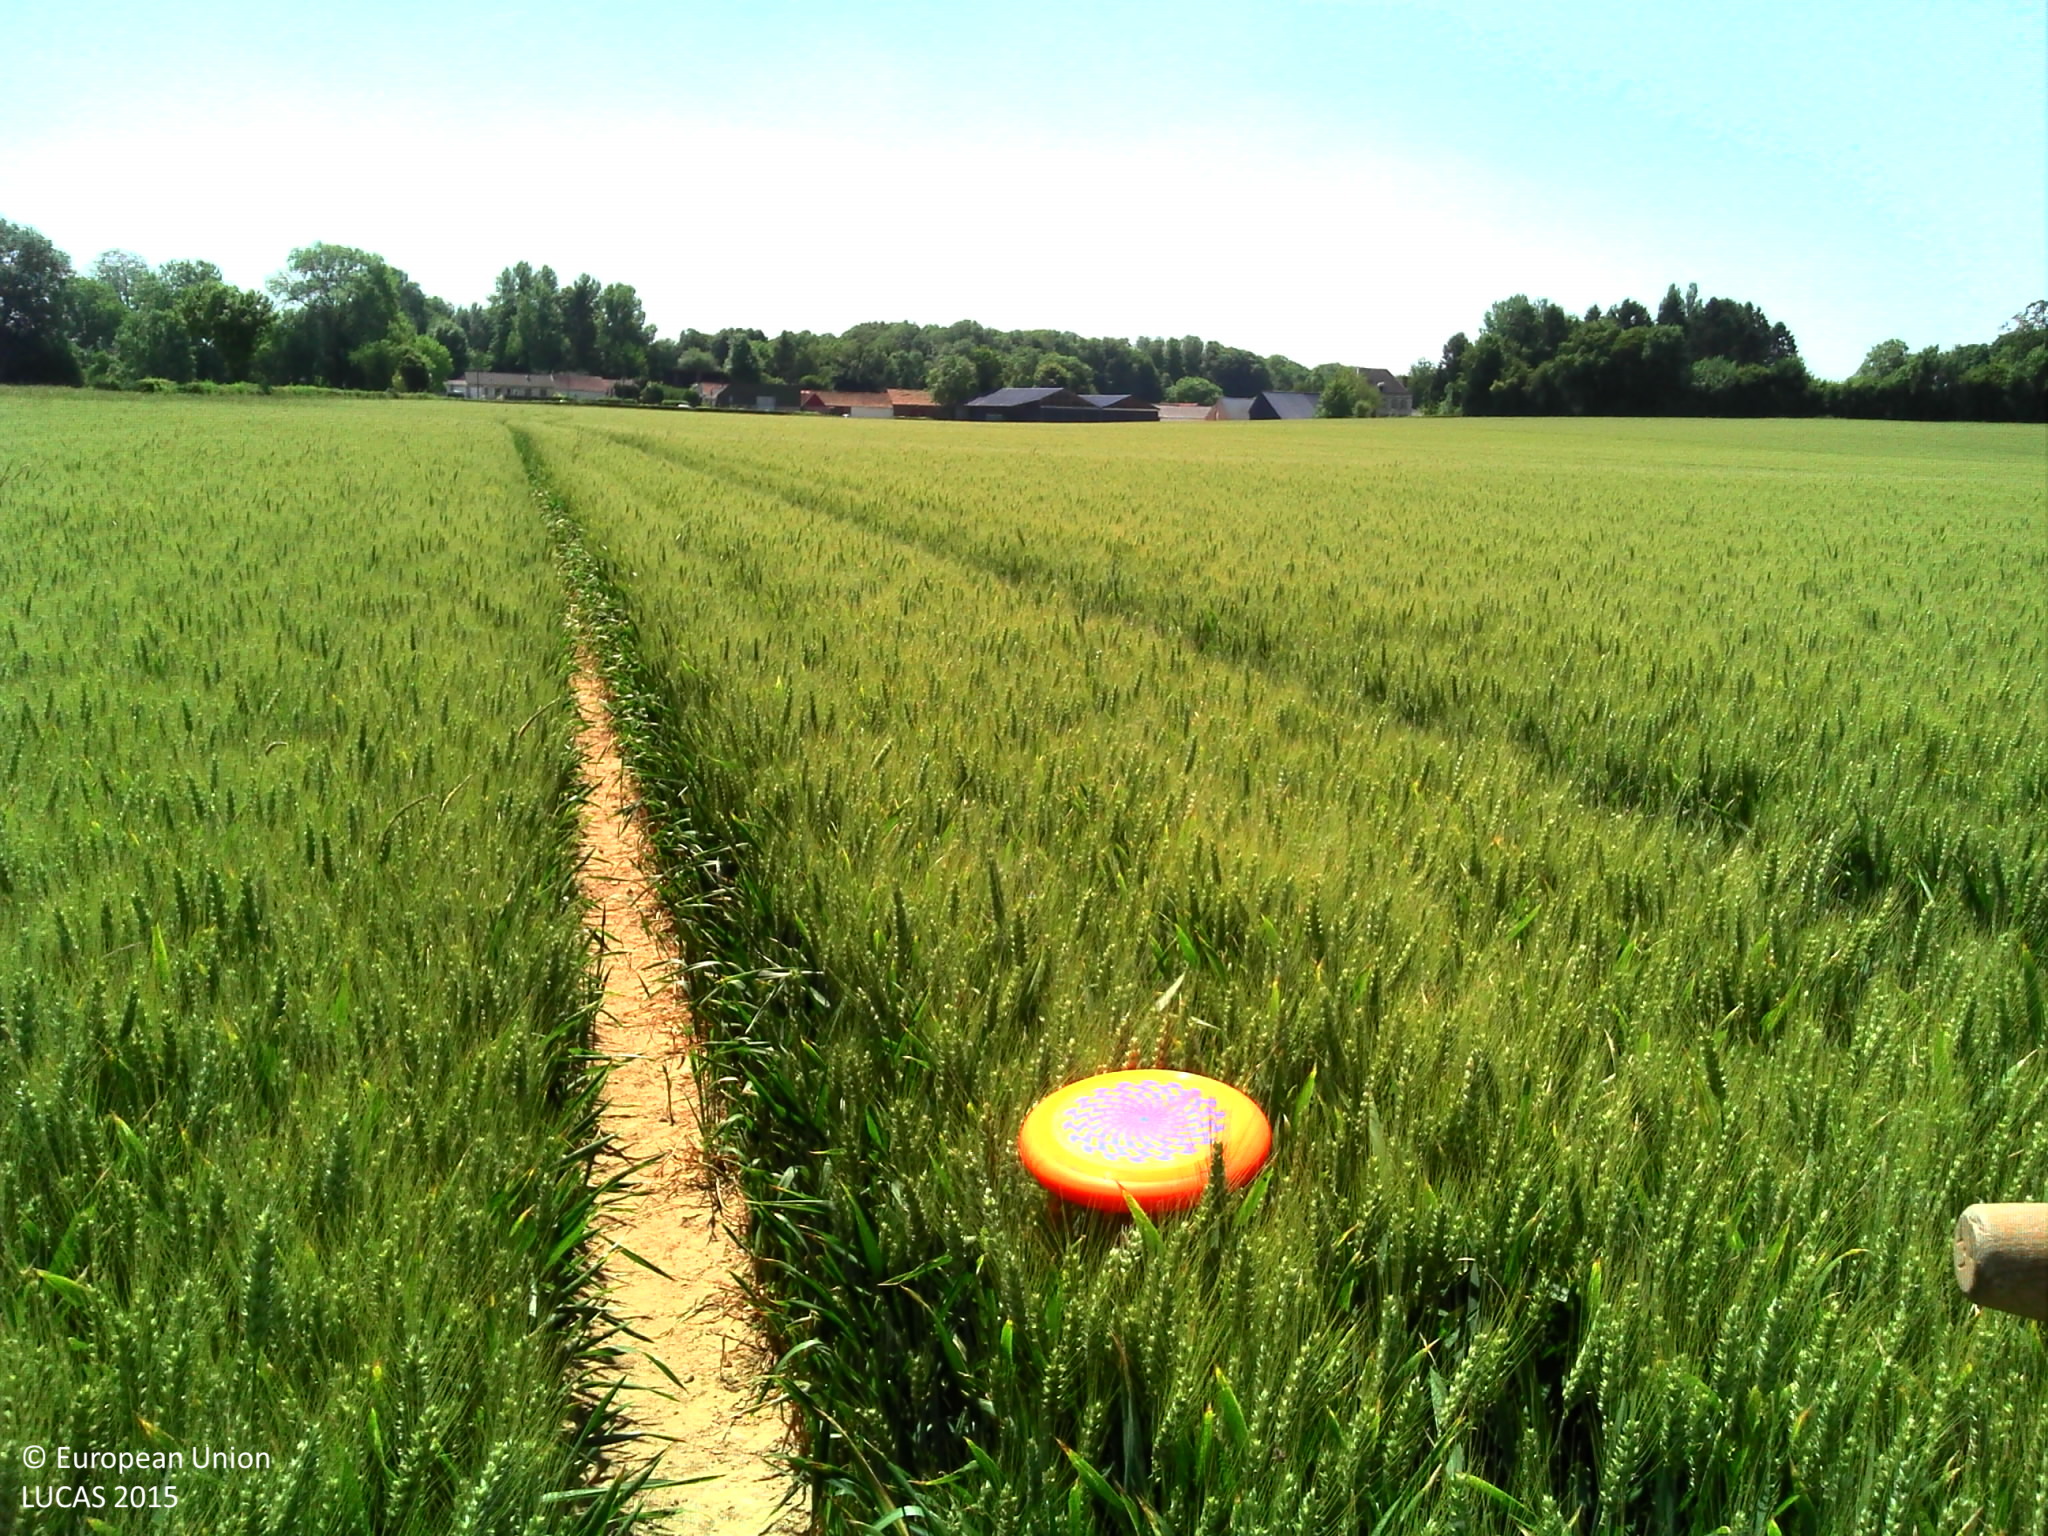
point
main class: Cropland
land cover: Common wheat
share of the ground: > 75 %
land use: Agriculture (excluding fallow land and kitchen gardens)
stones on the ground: < 10 %
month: June
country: FR
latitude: 50.3146
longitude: 2.4741
